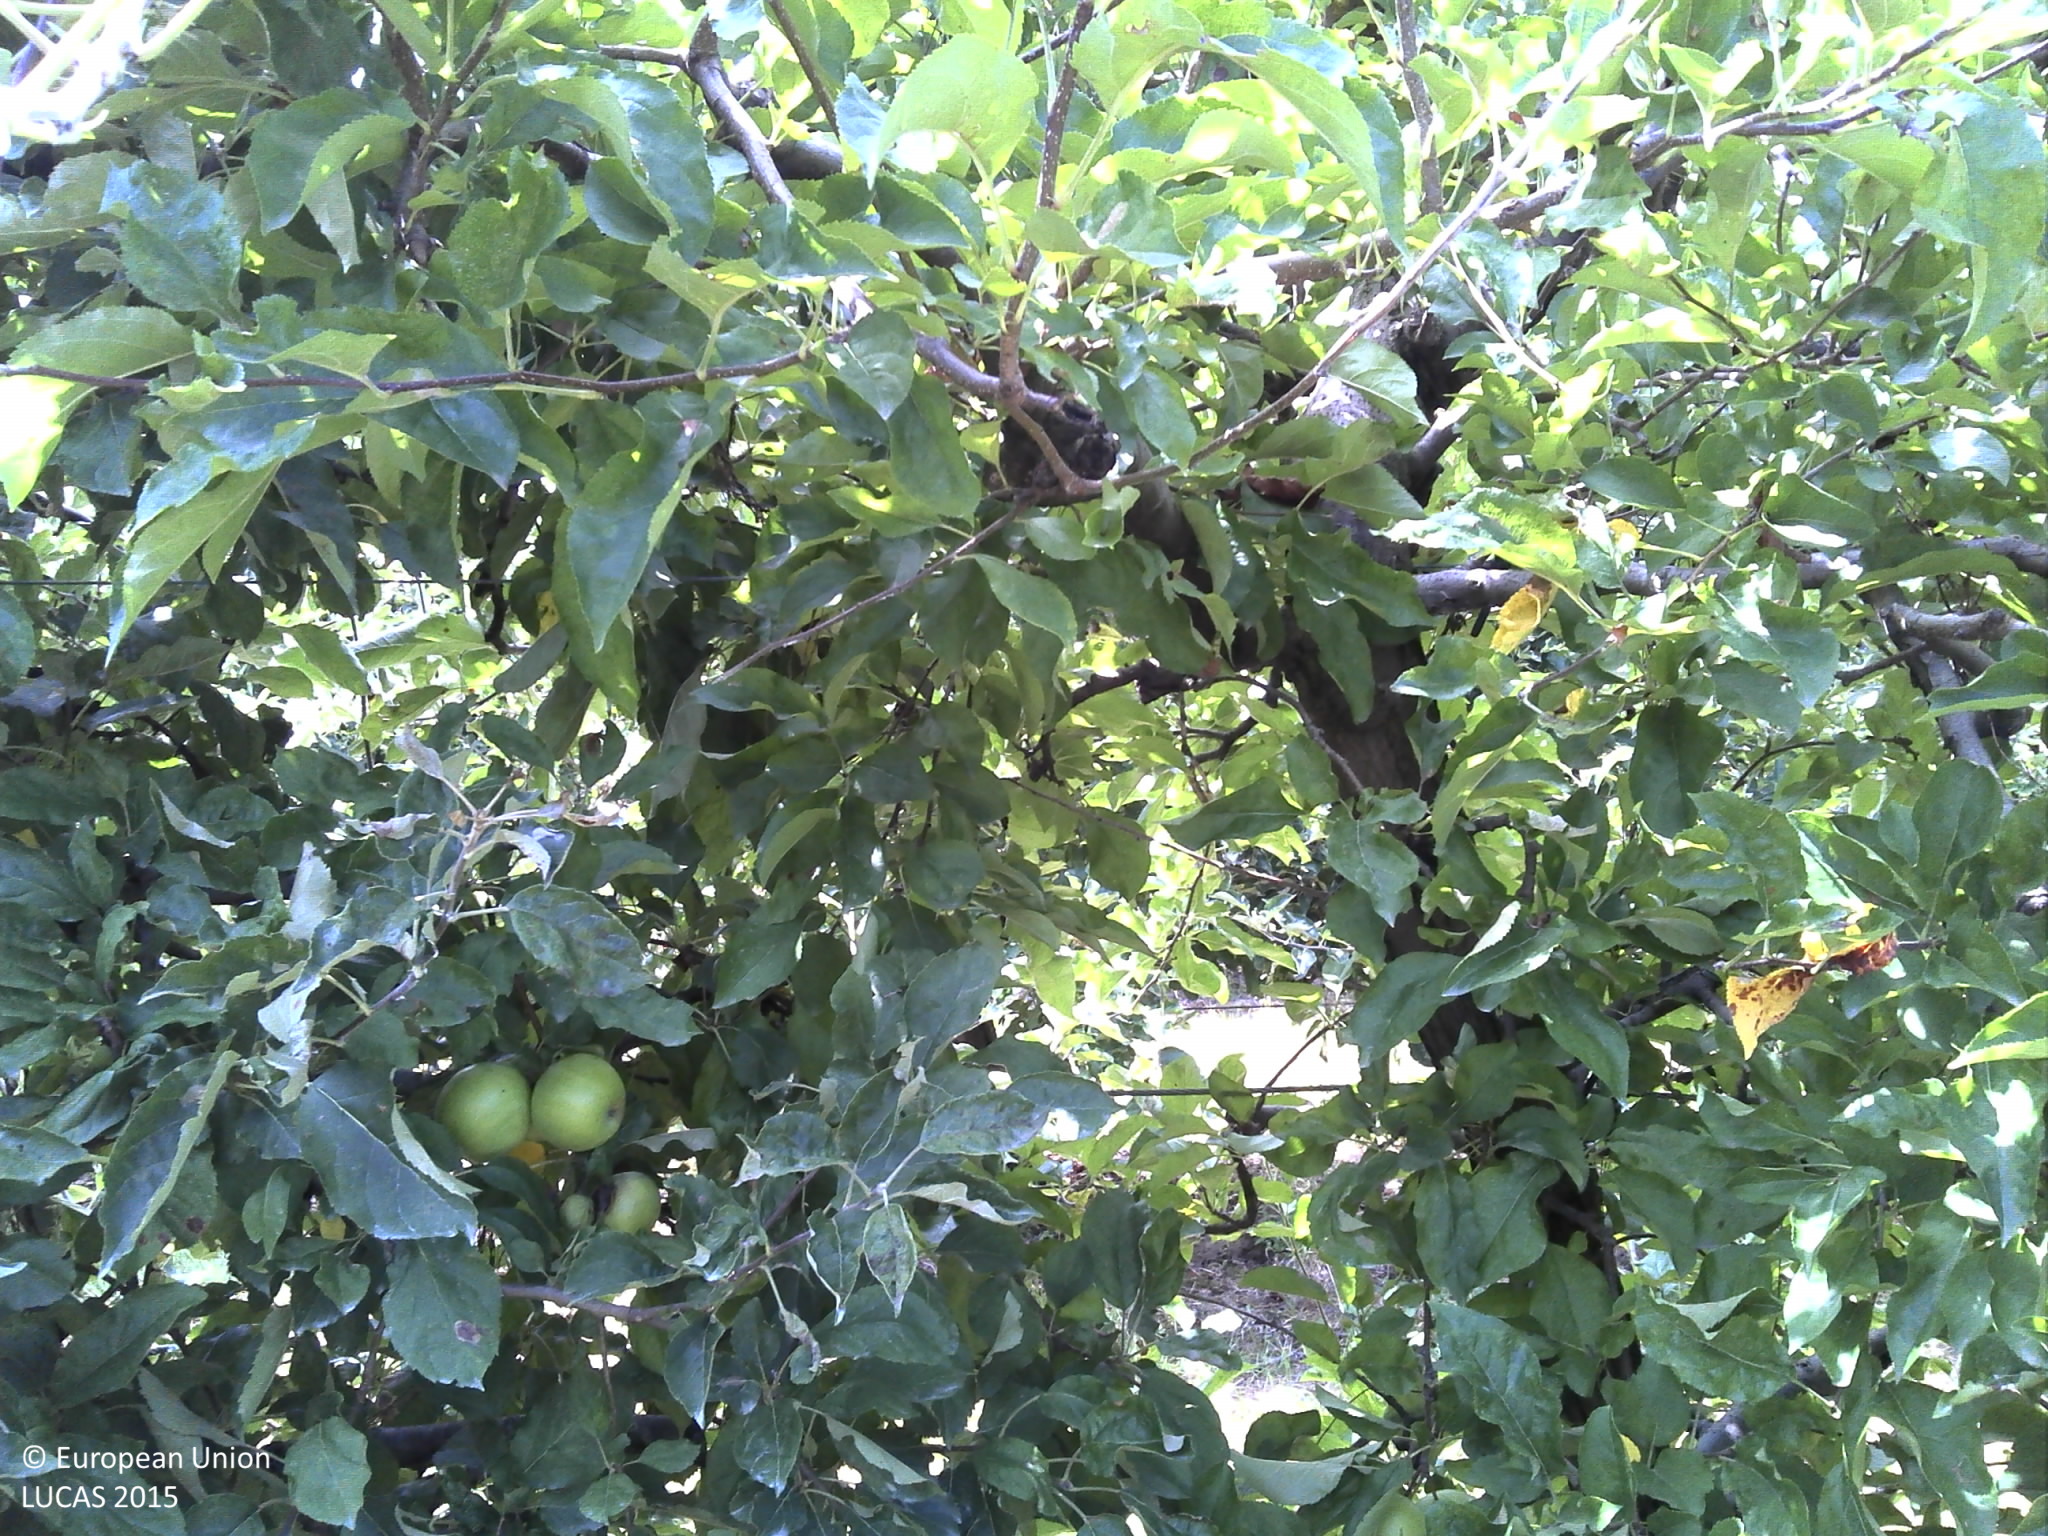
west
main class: Cropland
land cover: Apple fruit
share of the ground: > 75 %
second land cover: Spontaneously vegetated surfaces
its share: > 75 %
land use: Kitchen garden
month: July
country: HR
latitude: 45.6393
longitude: 16.6318
